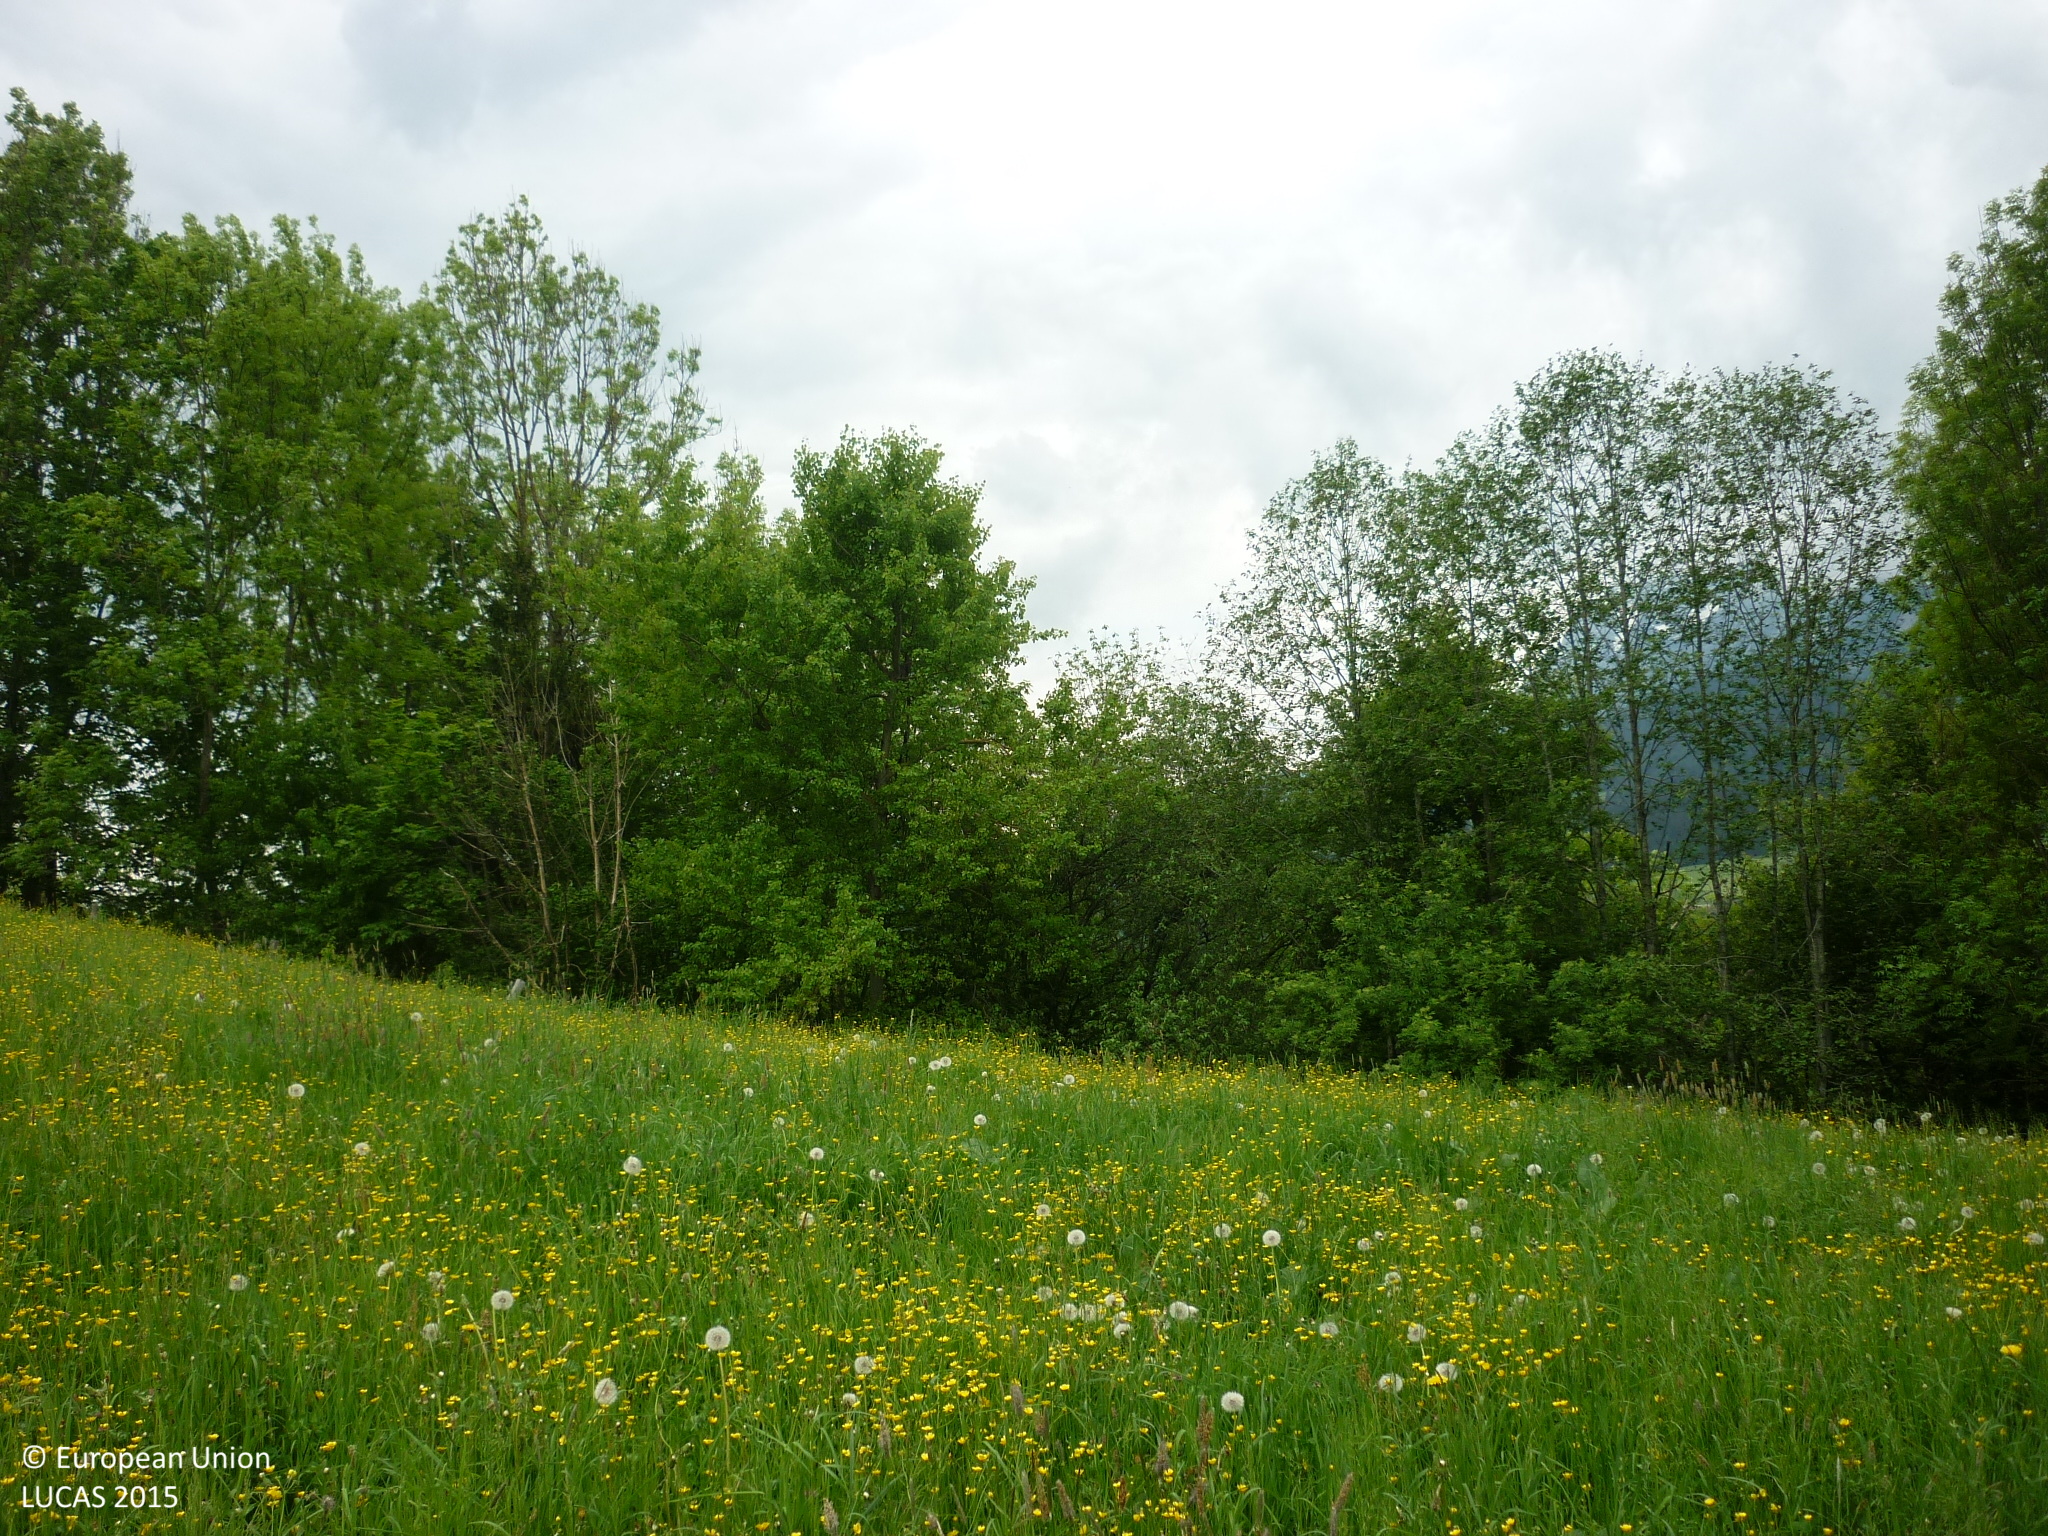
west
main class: Grassland
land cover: Grassland without tree/shrub cover
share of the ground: > 75 %
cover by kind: herbaceous plants 100 %
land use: Agriculture (excluding fallow land and kitchen gardens)
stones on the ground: < 10 %
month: May
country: AT
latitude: 47.4031
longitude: 13.7484
